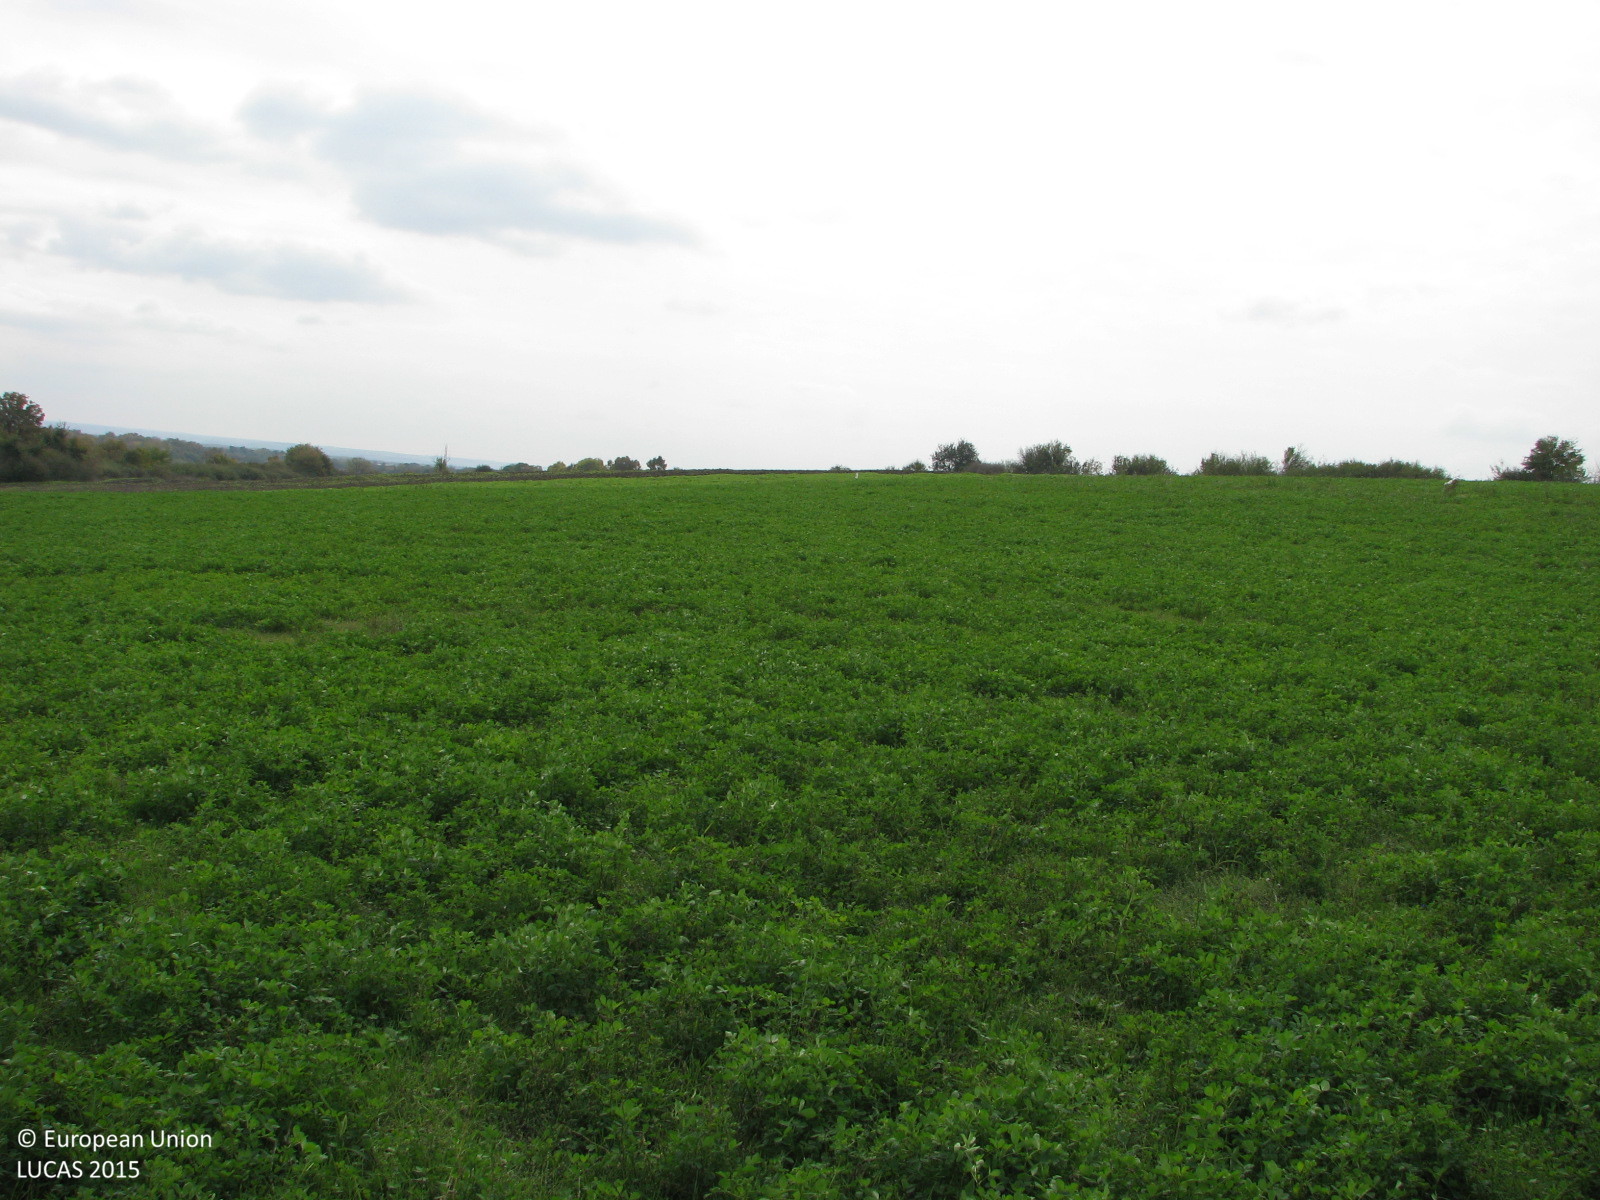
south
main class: Cropland
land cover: Lucerne
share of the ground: > 75 %
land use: Agriculture (excluding fallow land and kitchen gardens)
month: October
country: BG
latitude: 42.2191
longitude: 26.5534
